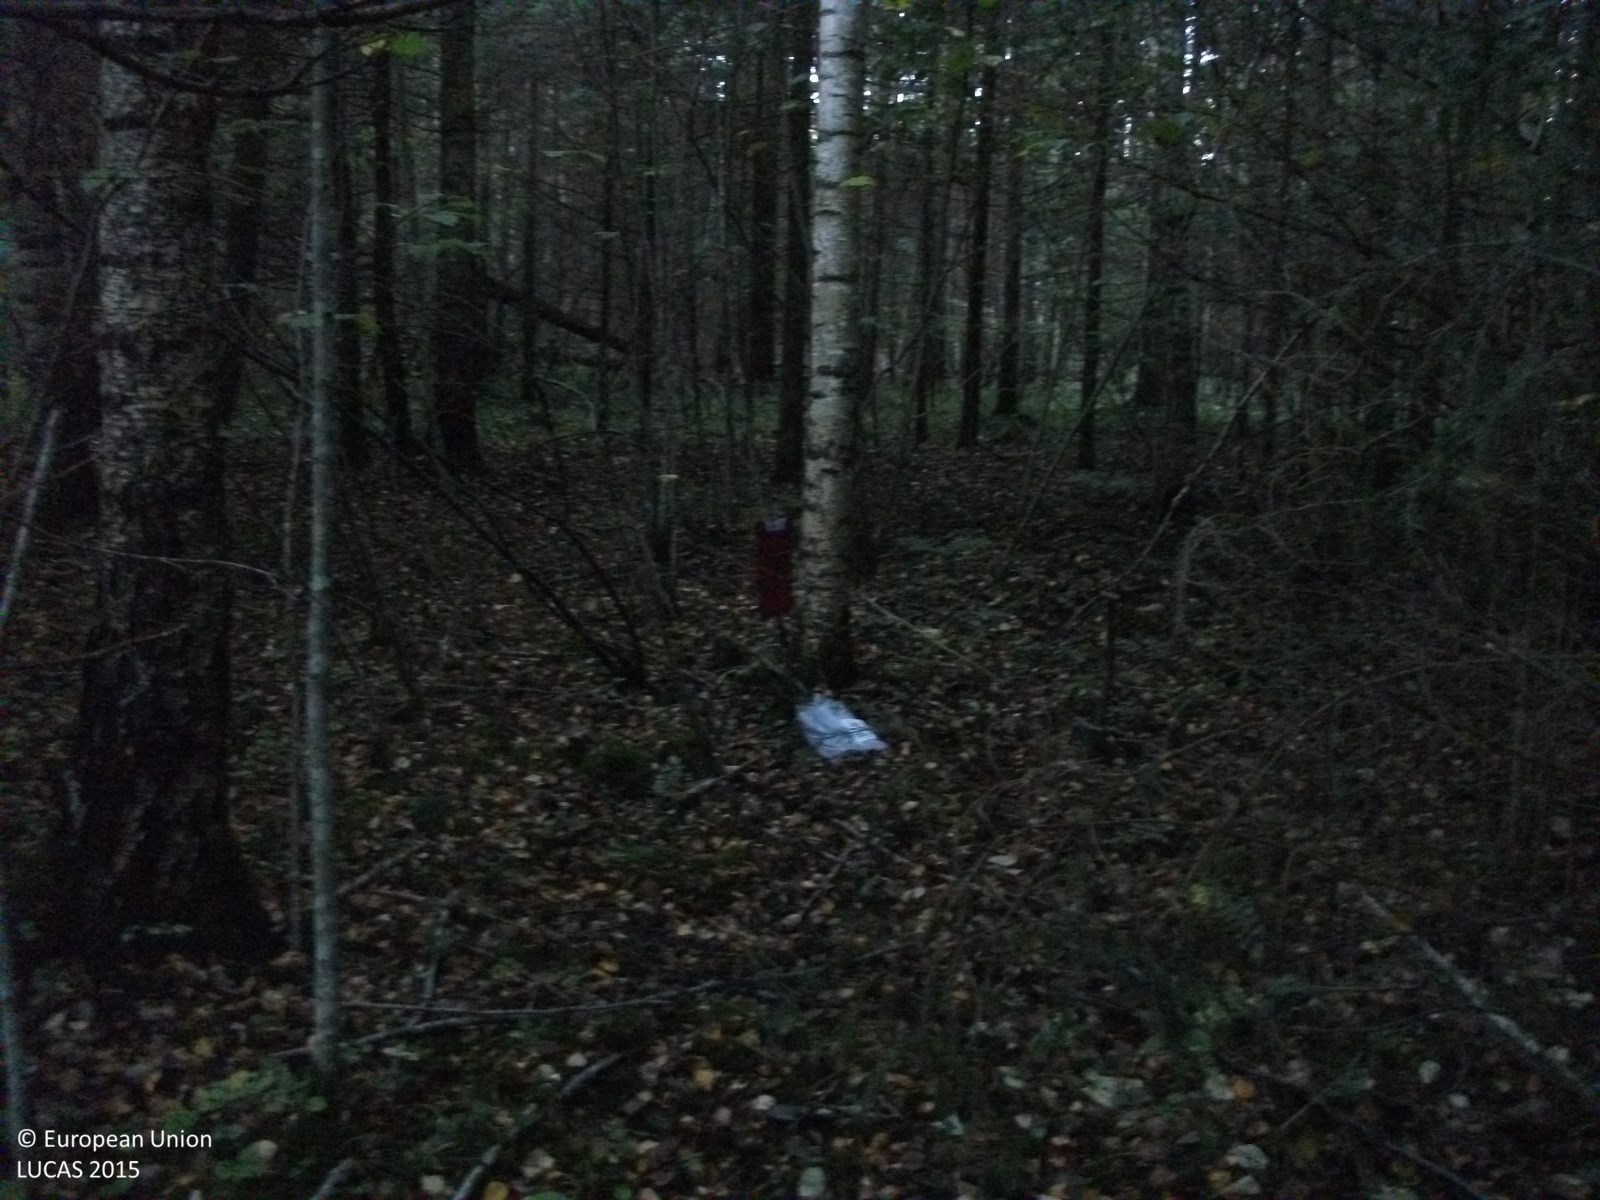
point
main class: Woodland
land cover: Spruce dominated mixed woodland
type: hemiboreal forest and nemoral coniferous forest and mixed broadleaved-coniferous forest
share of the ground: > 75 %
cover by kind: coniferous forest trees 55 %, broadleaved forest trees 35 %, herbaceous plants 5 %, unconsolidated bare surface 5 %
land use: Forestry
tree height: > 5 m
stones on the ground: < 10 %
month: September
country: LV
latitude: 57.7848
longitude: 24.7438
